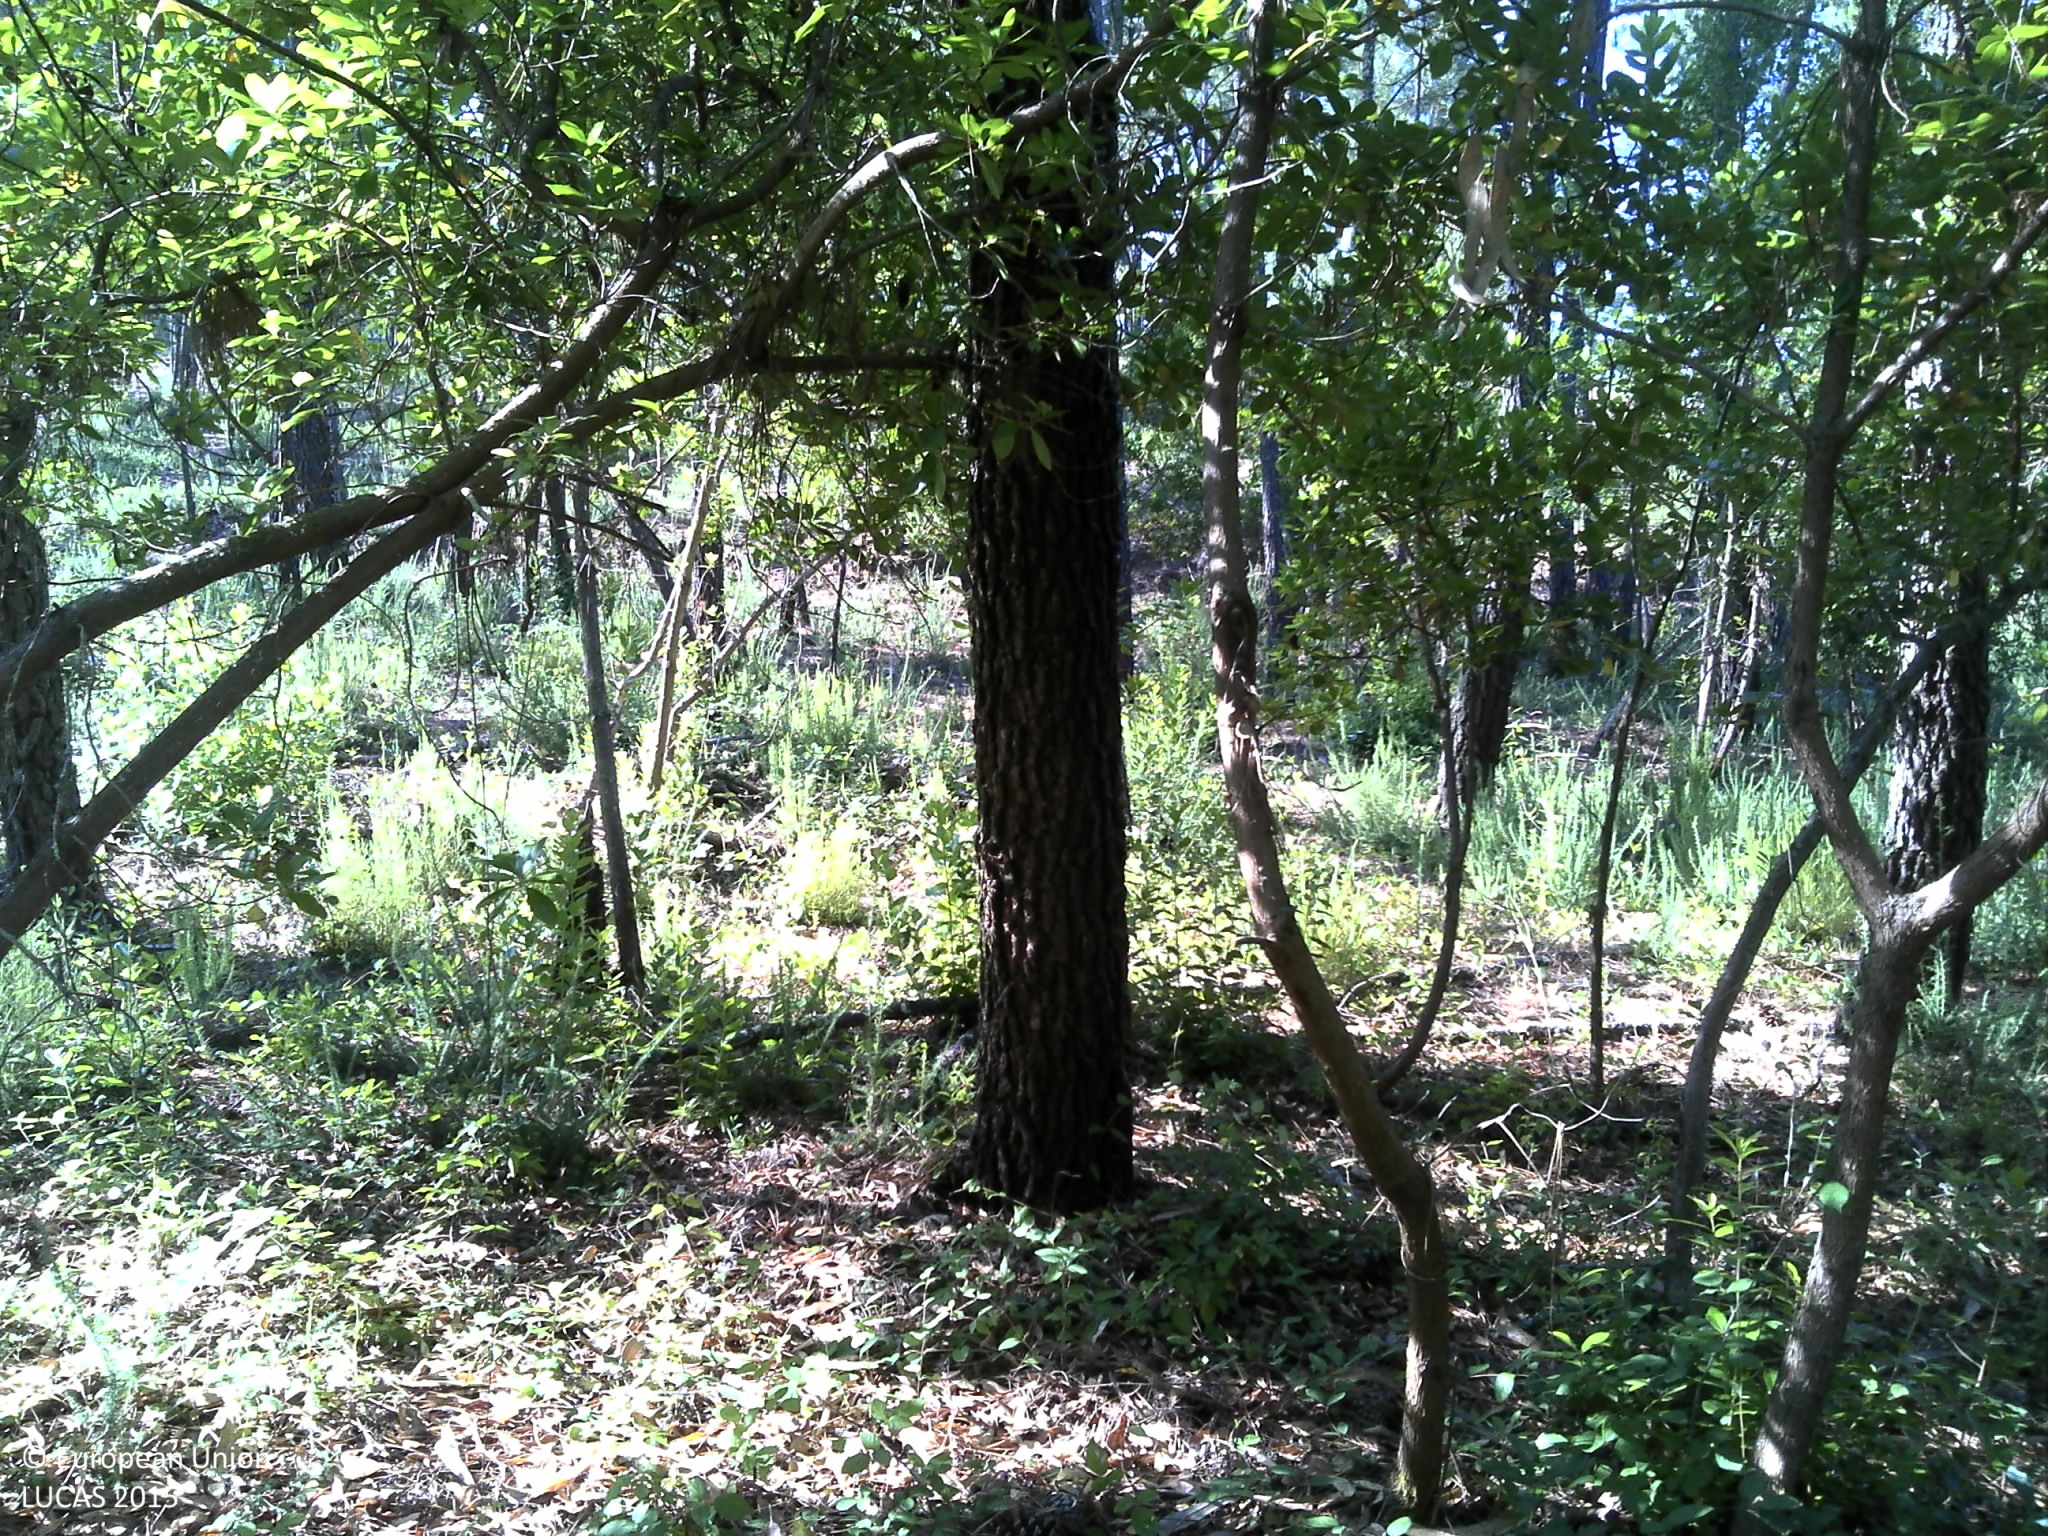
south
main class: Woodland
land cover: Pine dominated coniferous woodland
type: coniferous forest of the mediterranean region
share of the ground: 10 - 25 %
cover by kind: herbaceous plants 50 %, unconsolidated bare surface 30 %, coniferous forest trees 20 %
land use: Forestry
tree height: > 5 m
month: June
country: PT
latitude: 40.1326
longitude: -8.2323
